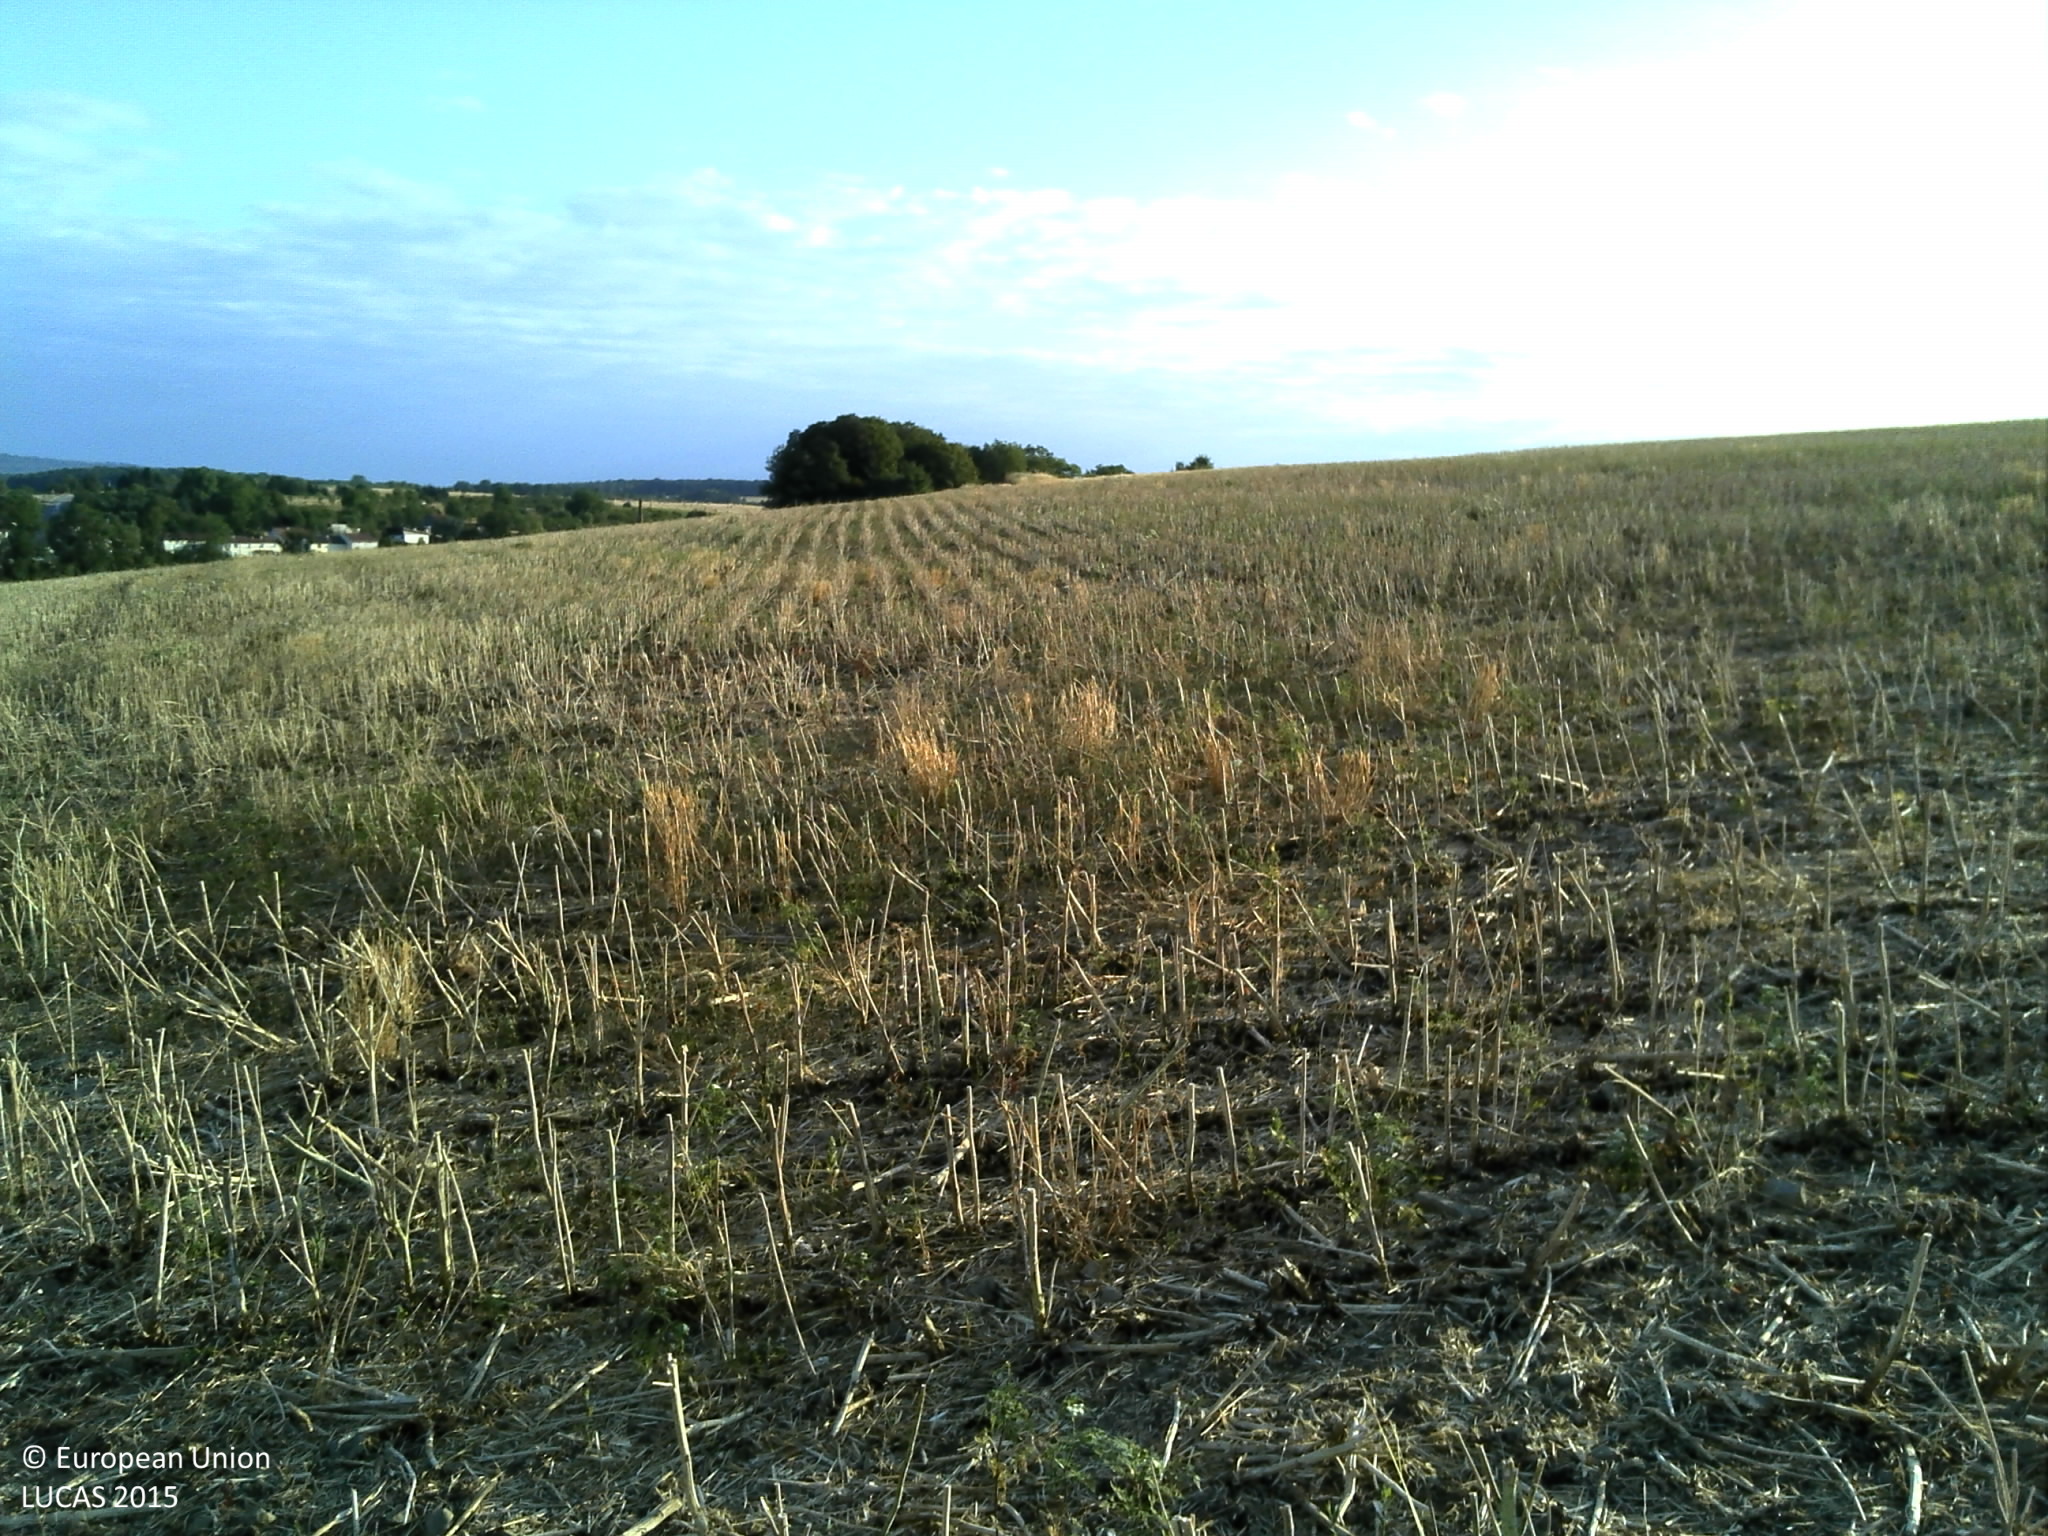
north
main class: Cropland
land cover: Rape and turnip rape
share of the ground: < 10 %
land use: Agriculture (excluding fallow land and kitchen gardens)
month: July
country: FR
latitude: 48.3178
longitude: 6.1300
